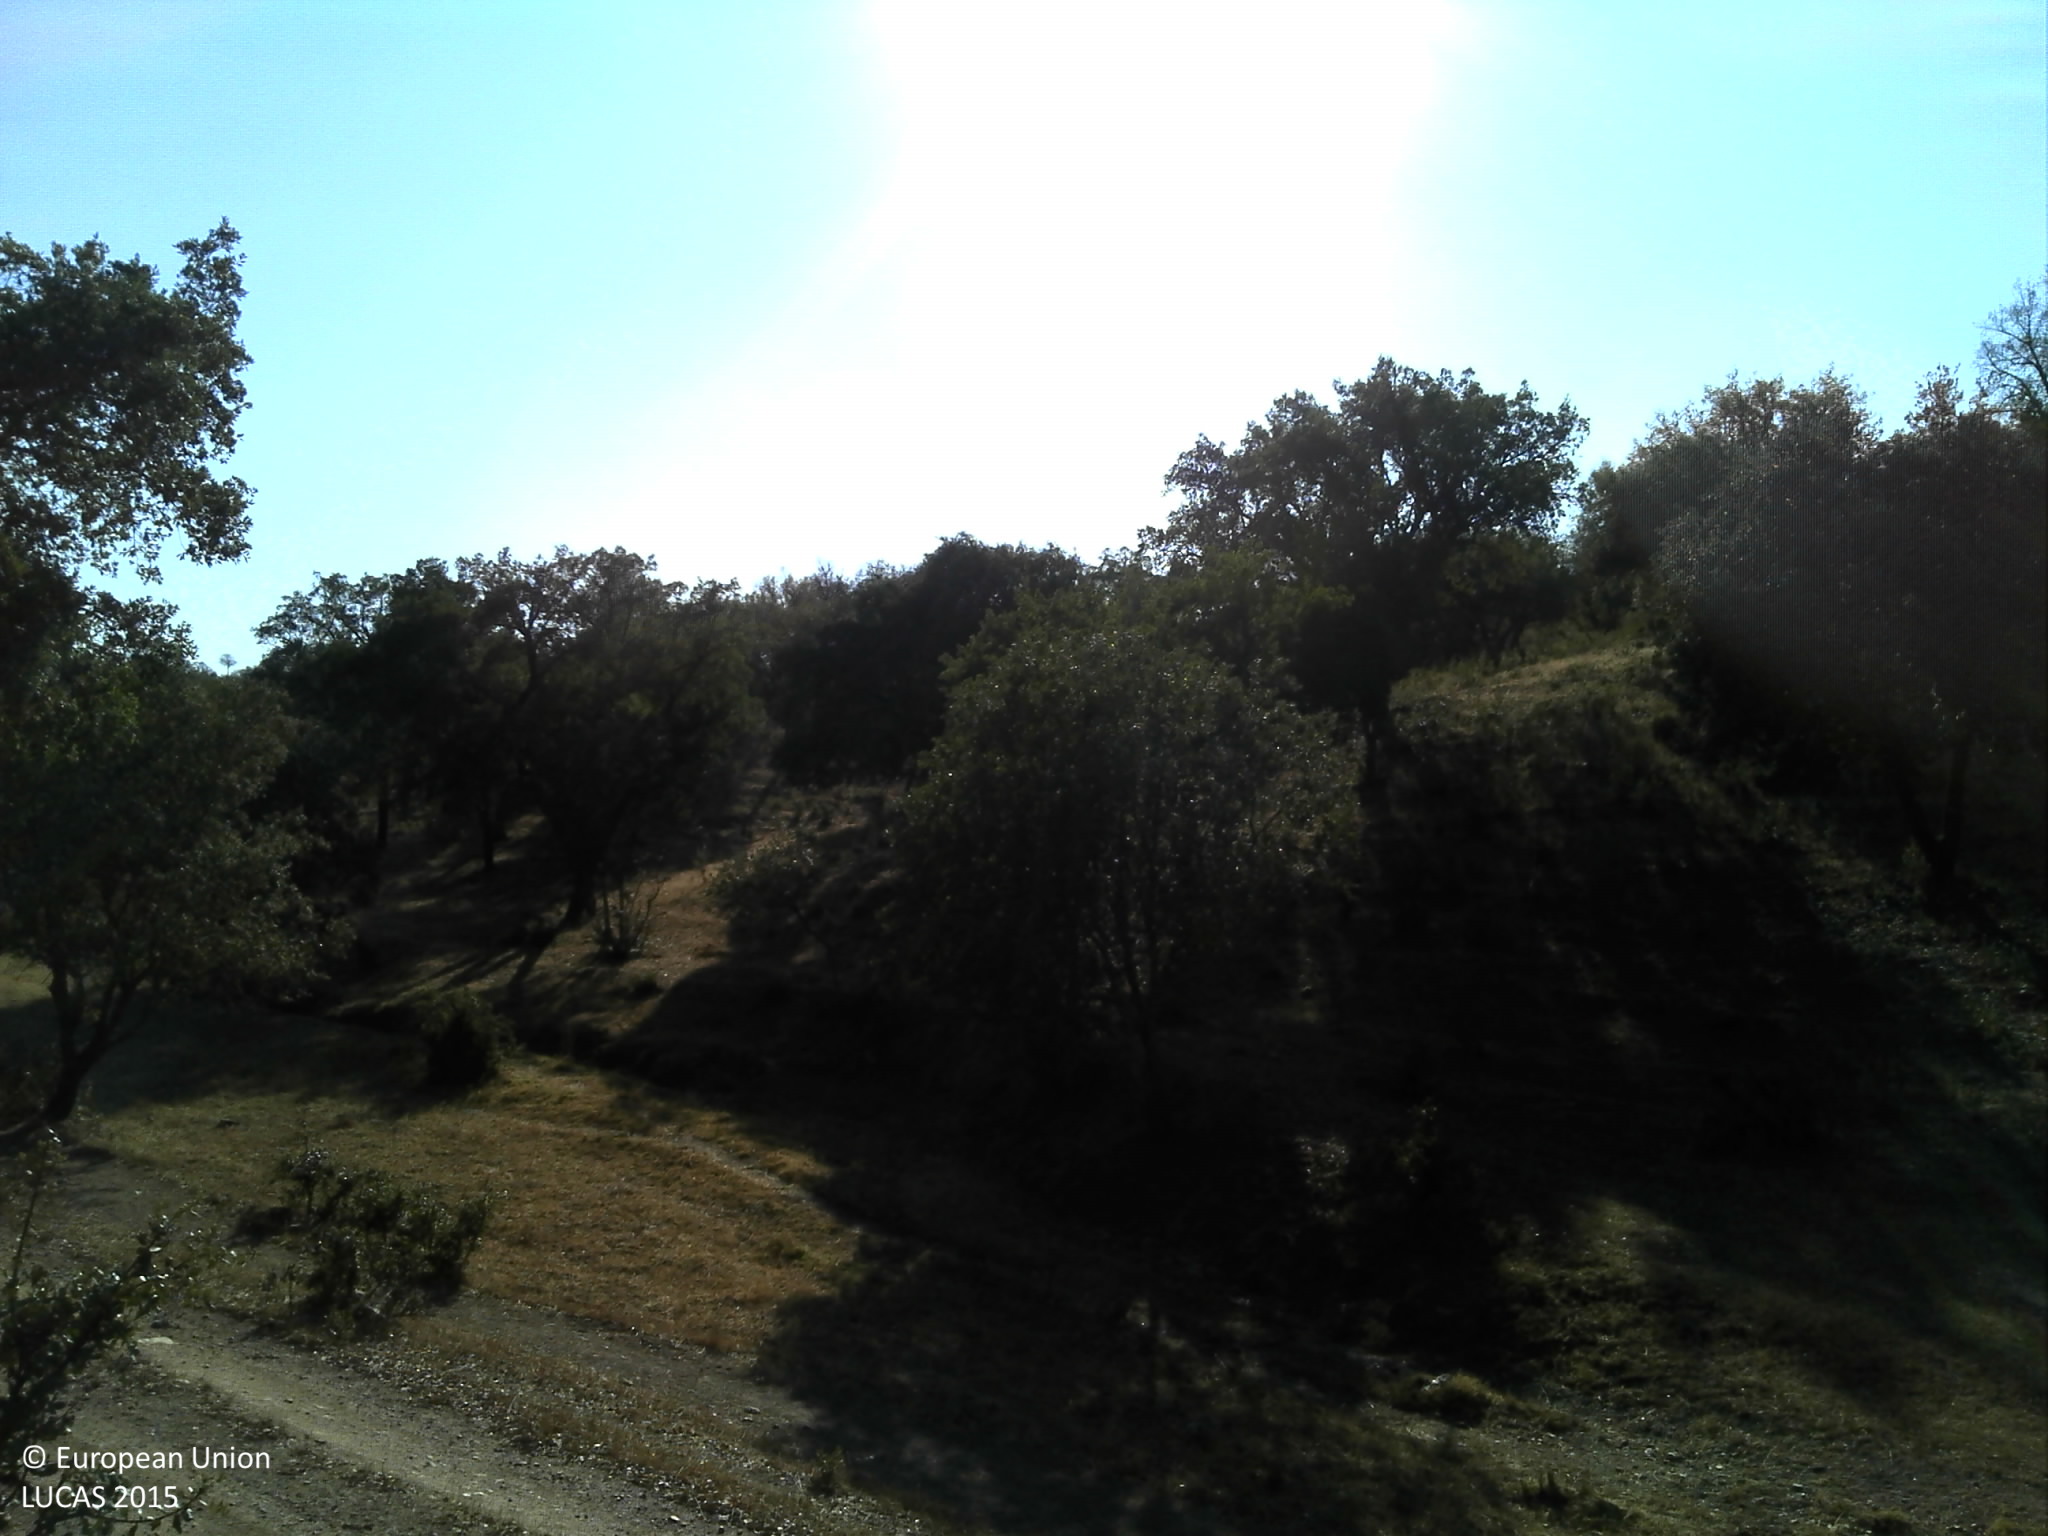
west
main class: Woodland
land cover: Broadleaved woodland
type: broadleaved evergreen forest
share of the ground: 25 - 50 %
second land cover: Grassland without tree/shrub cover
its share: 10 - 25 %
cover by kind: broadleaved forest trees 45 %, unconsolidated bare surface 40 %, herbaceous plants 15 %
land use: Forestry
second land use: Agriculture (excluding fallow land and kitchen gardens)
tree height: > 5 m
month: July
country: PT
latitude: 38.5087
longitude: -7.7288
